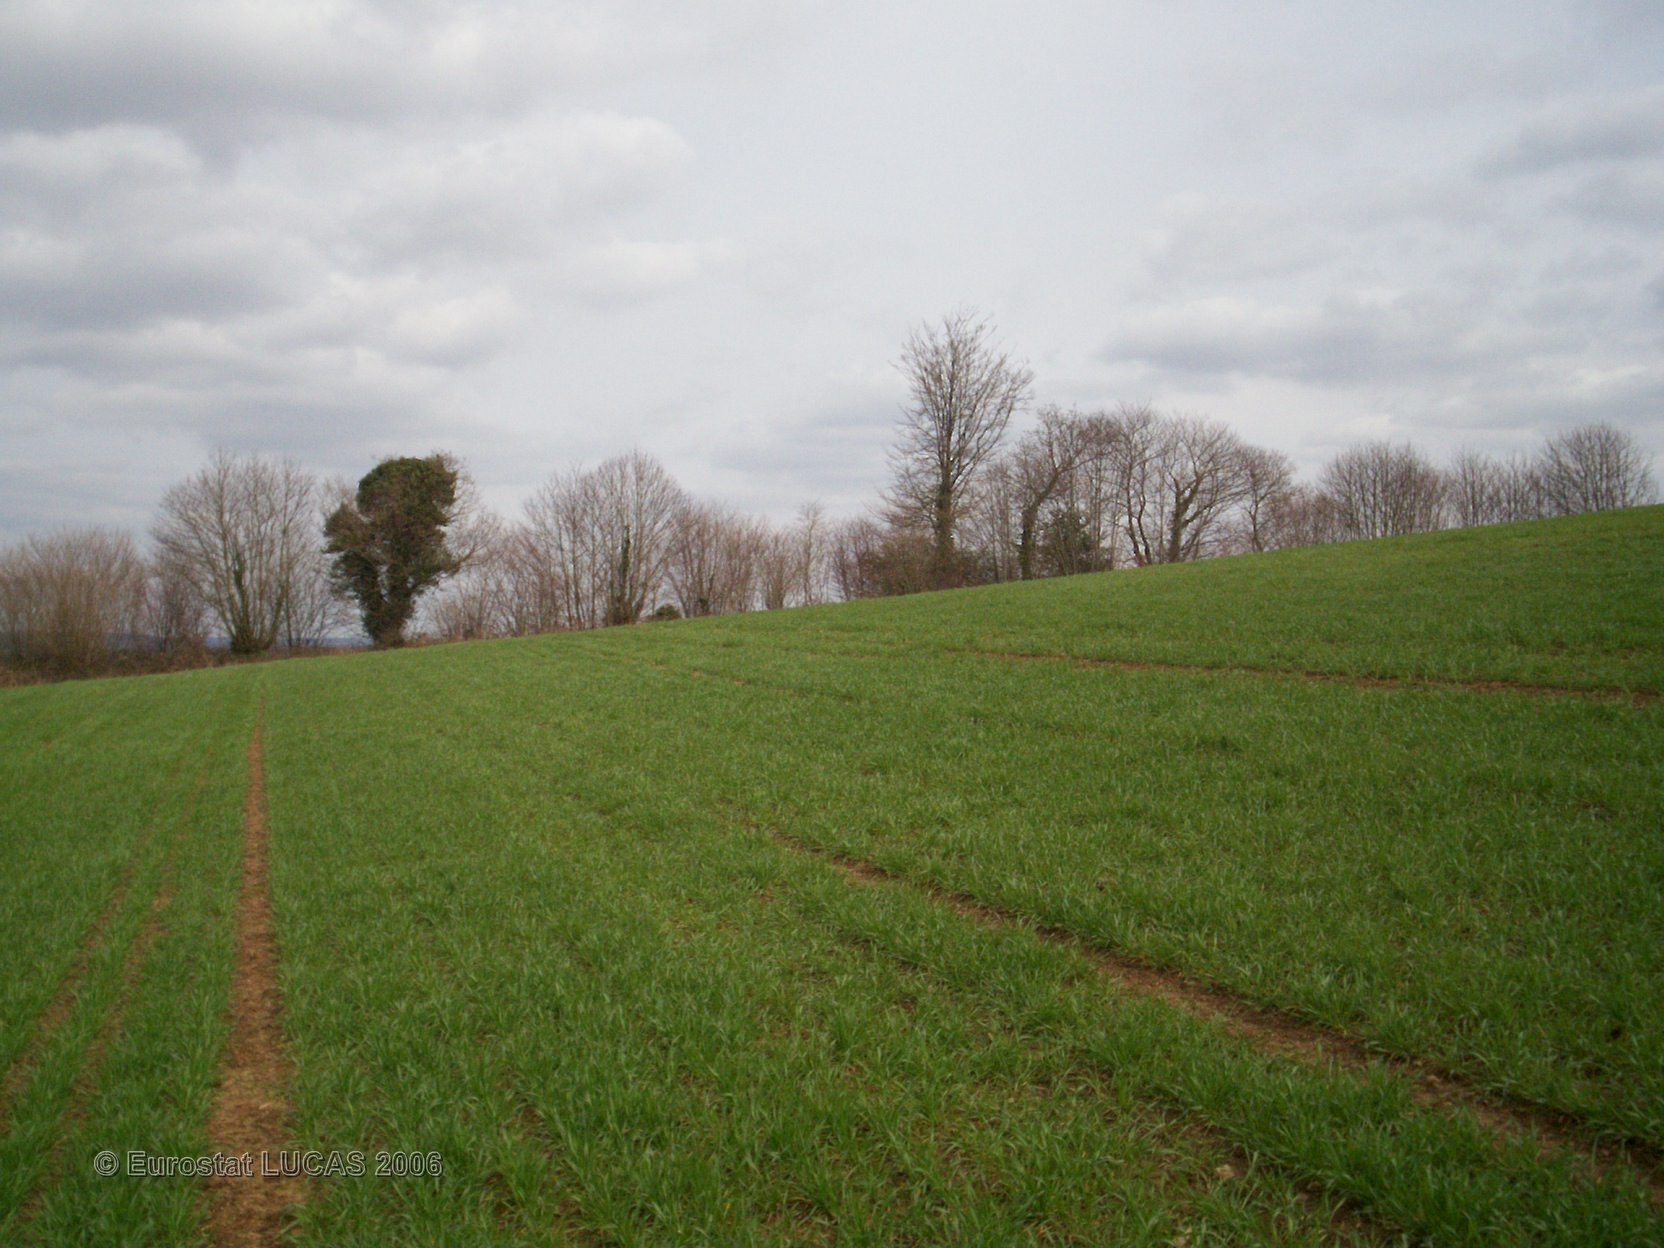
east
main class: Cropland
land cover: Common wheat
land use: Agriculture (excluding fallow land and kitchen gardens)
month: April
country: FR
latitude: 48.1262
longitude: -3.5813
